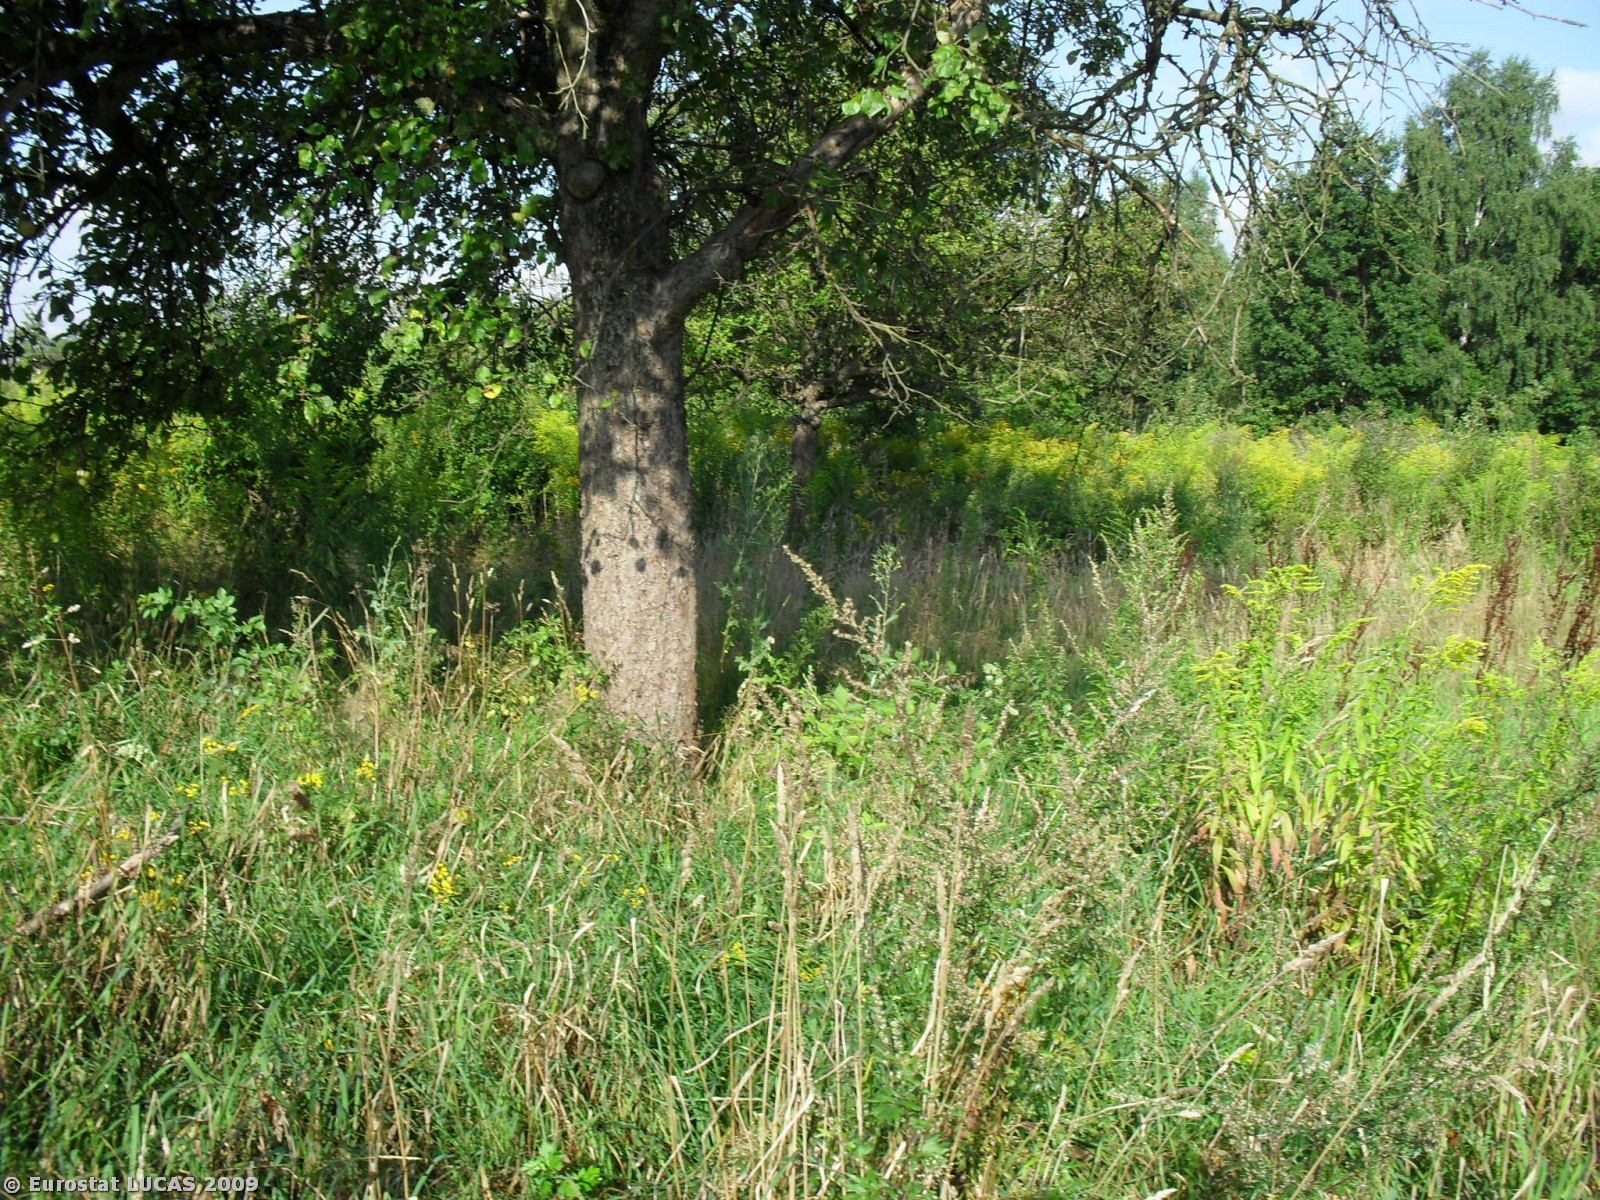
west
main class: Grassland
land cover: Grassland with sparse tree/shrub cover
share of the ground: > 75 %
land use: Agriculture (excluding fallow land and kitchen gardens)
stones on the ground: < 10 %
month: August
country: PL
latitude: 51.8123
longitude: 19.5289
